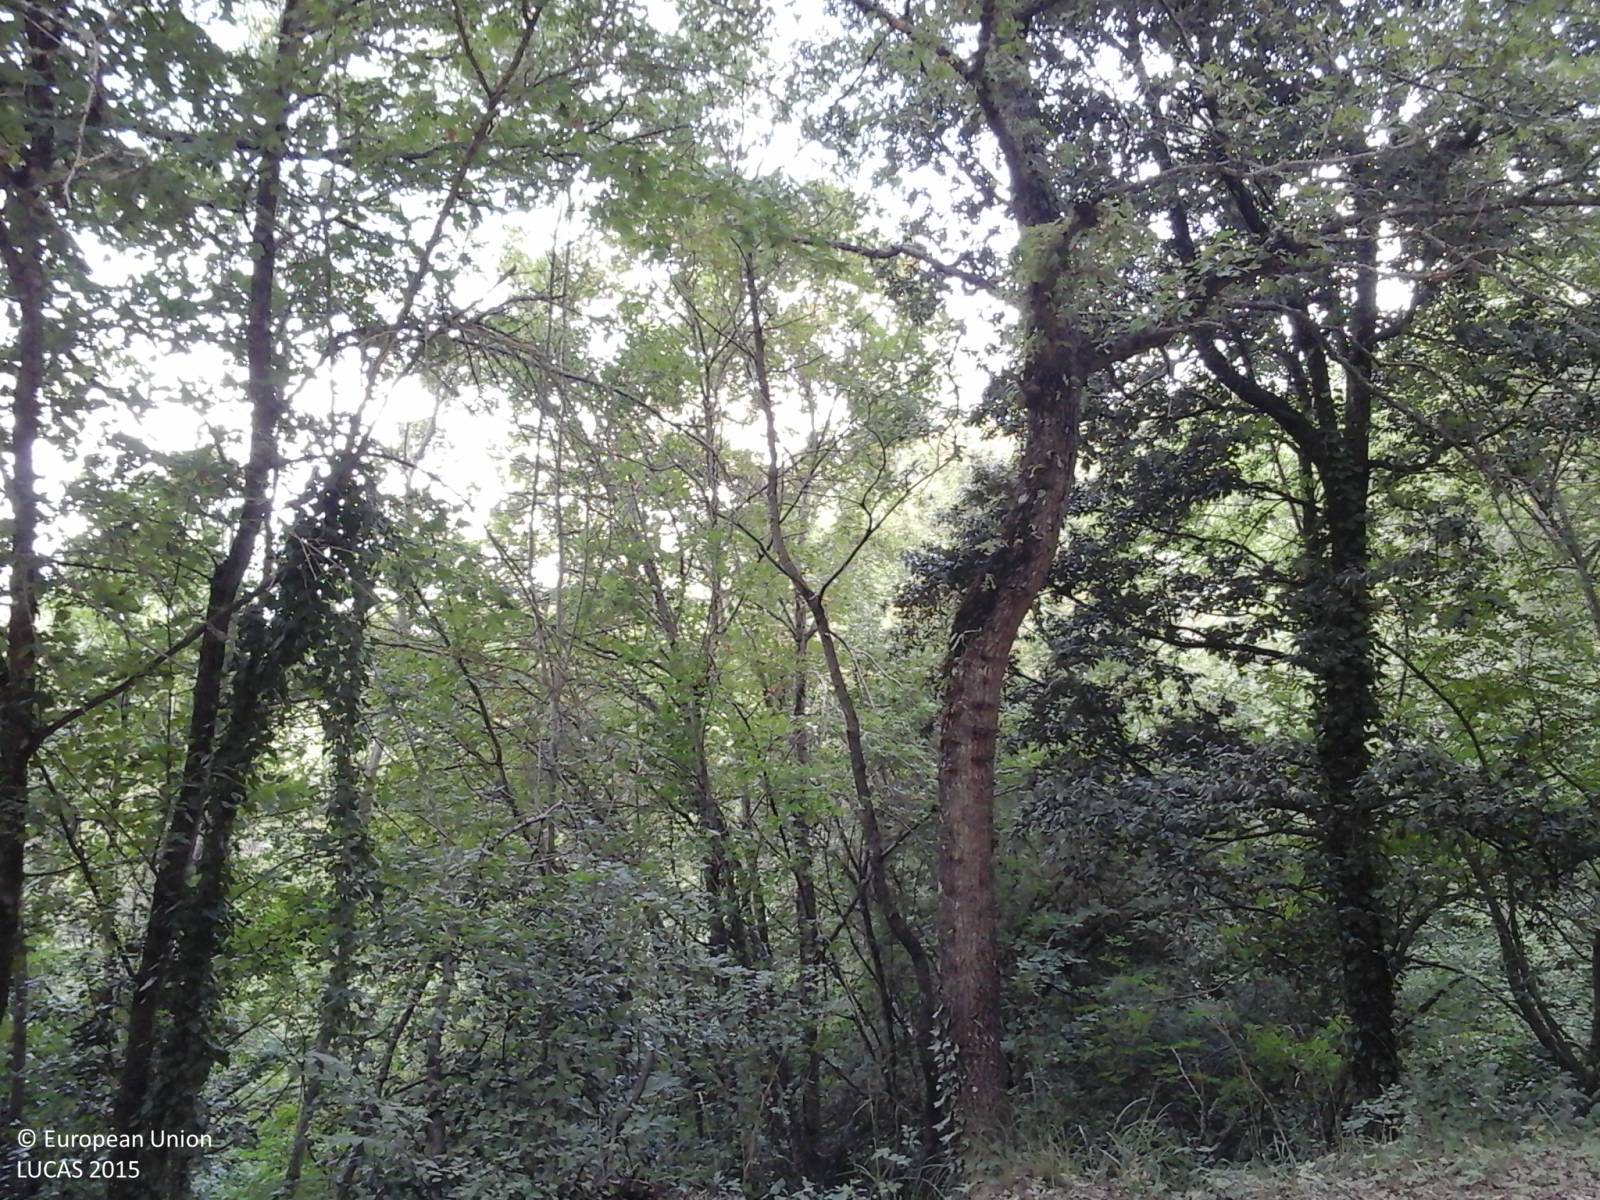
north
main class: Woodland
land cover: Broadleaved woodland
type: mesophytic deciduous forest
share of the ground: > 75 %
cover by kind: broadleaved forest trees 95 %, shrubs 5 %
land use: Forestry
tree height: > 5 m
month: September
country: IT
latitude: 43.0123
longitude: 12.0673
